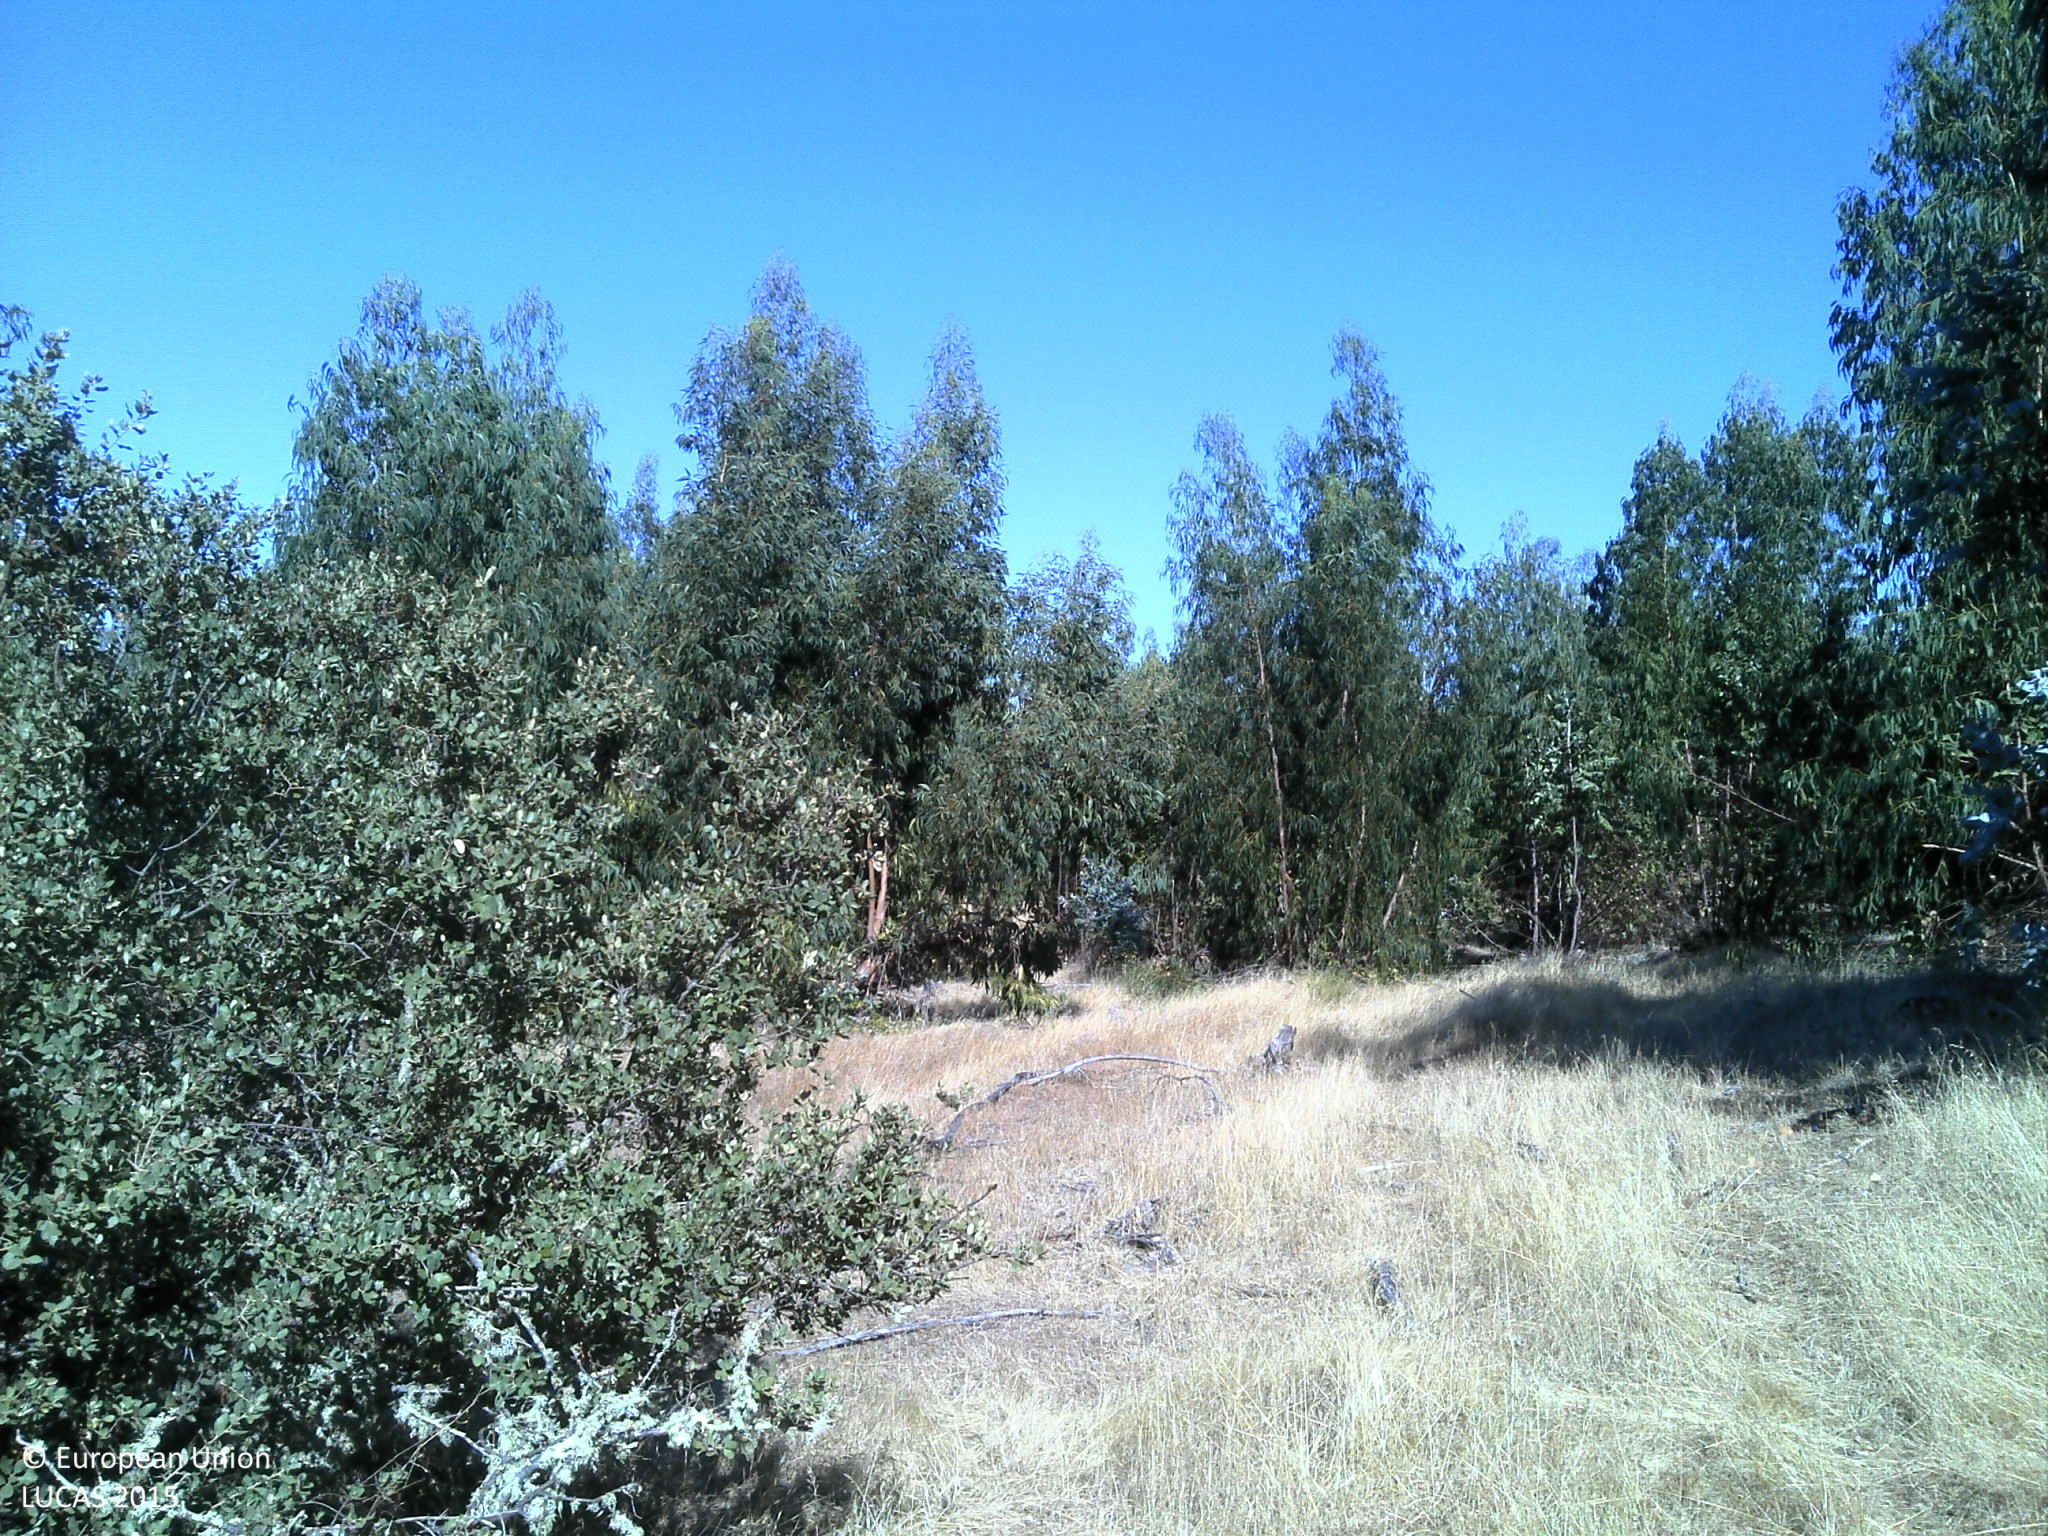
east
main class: Woodland
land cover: Broadleaved woodland
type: exotic forest
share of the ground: 25 - 50 %
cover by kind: unconsolidated bare surface 50 %, broadleaved forest trees 30 %, herbaceous plants 20 %
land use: Forestry
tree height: > 5 m
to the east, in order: Broadleaved woodland; Other mixed woodland
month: July
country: PT
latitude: 39.0016
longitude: -7.4613
